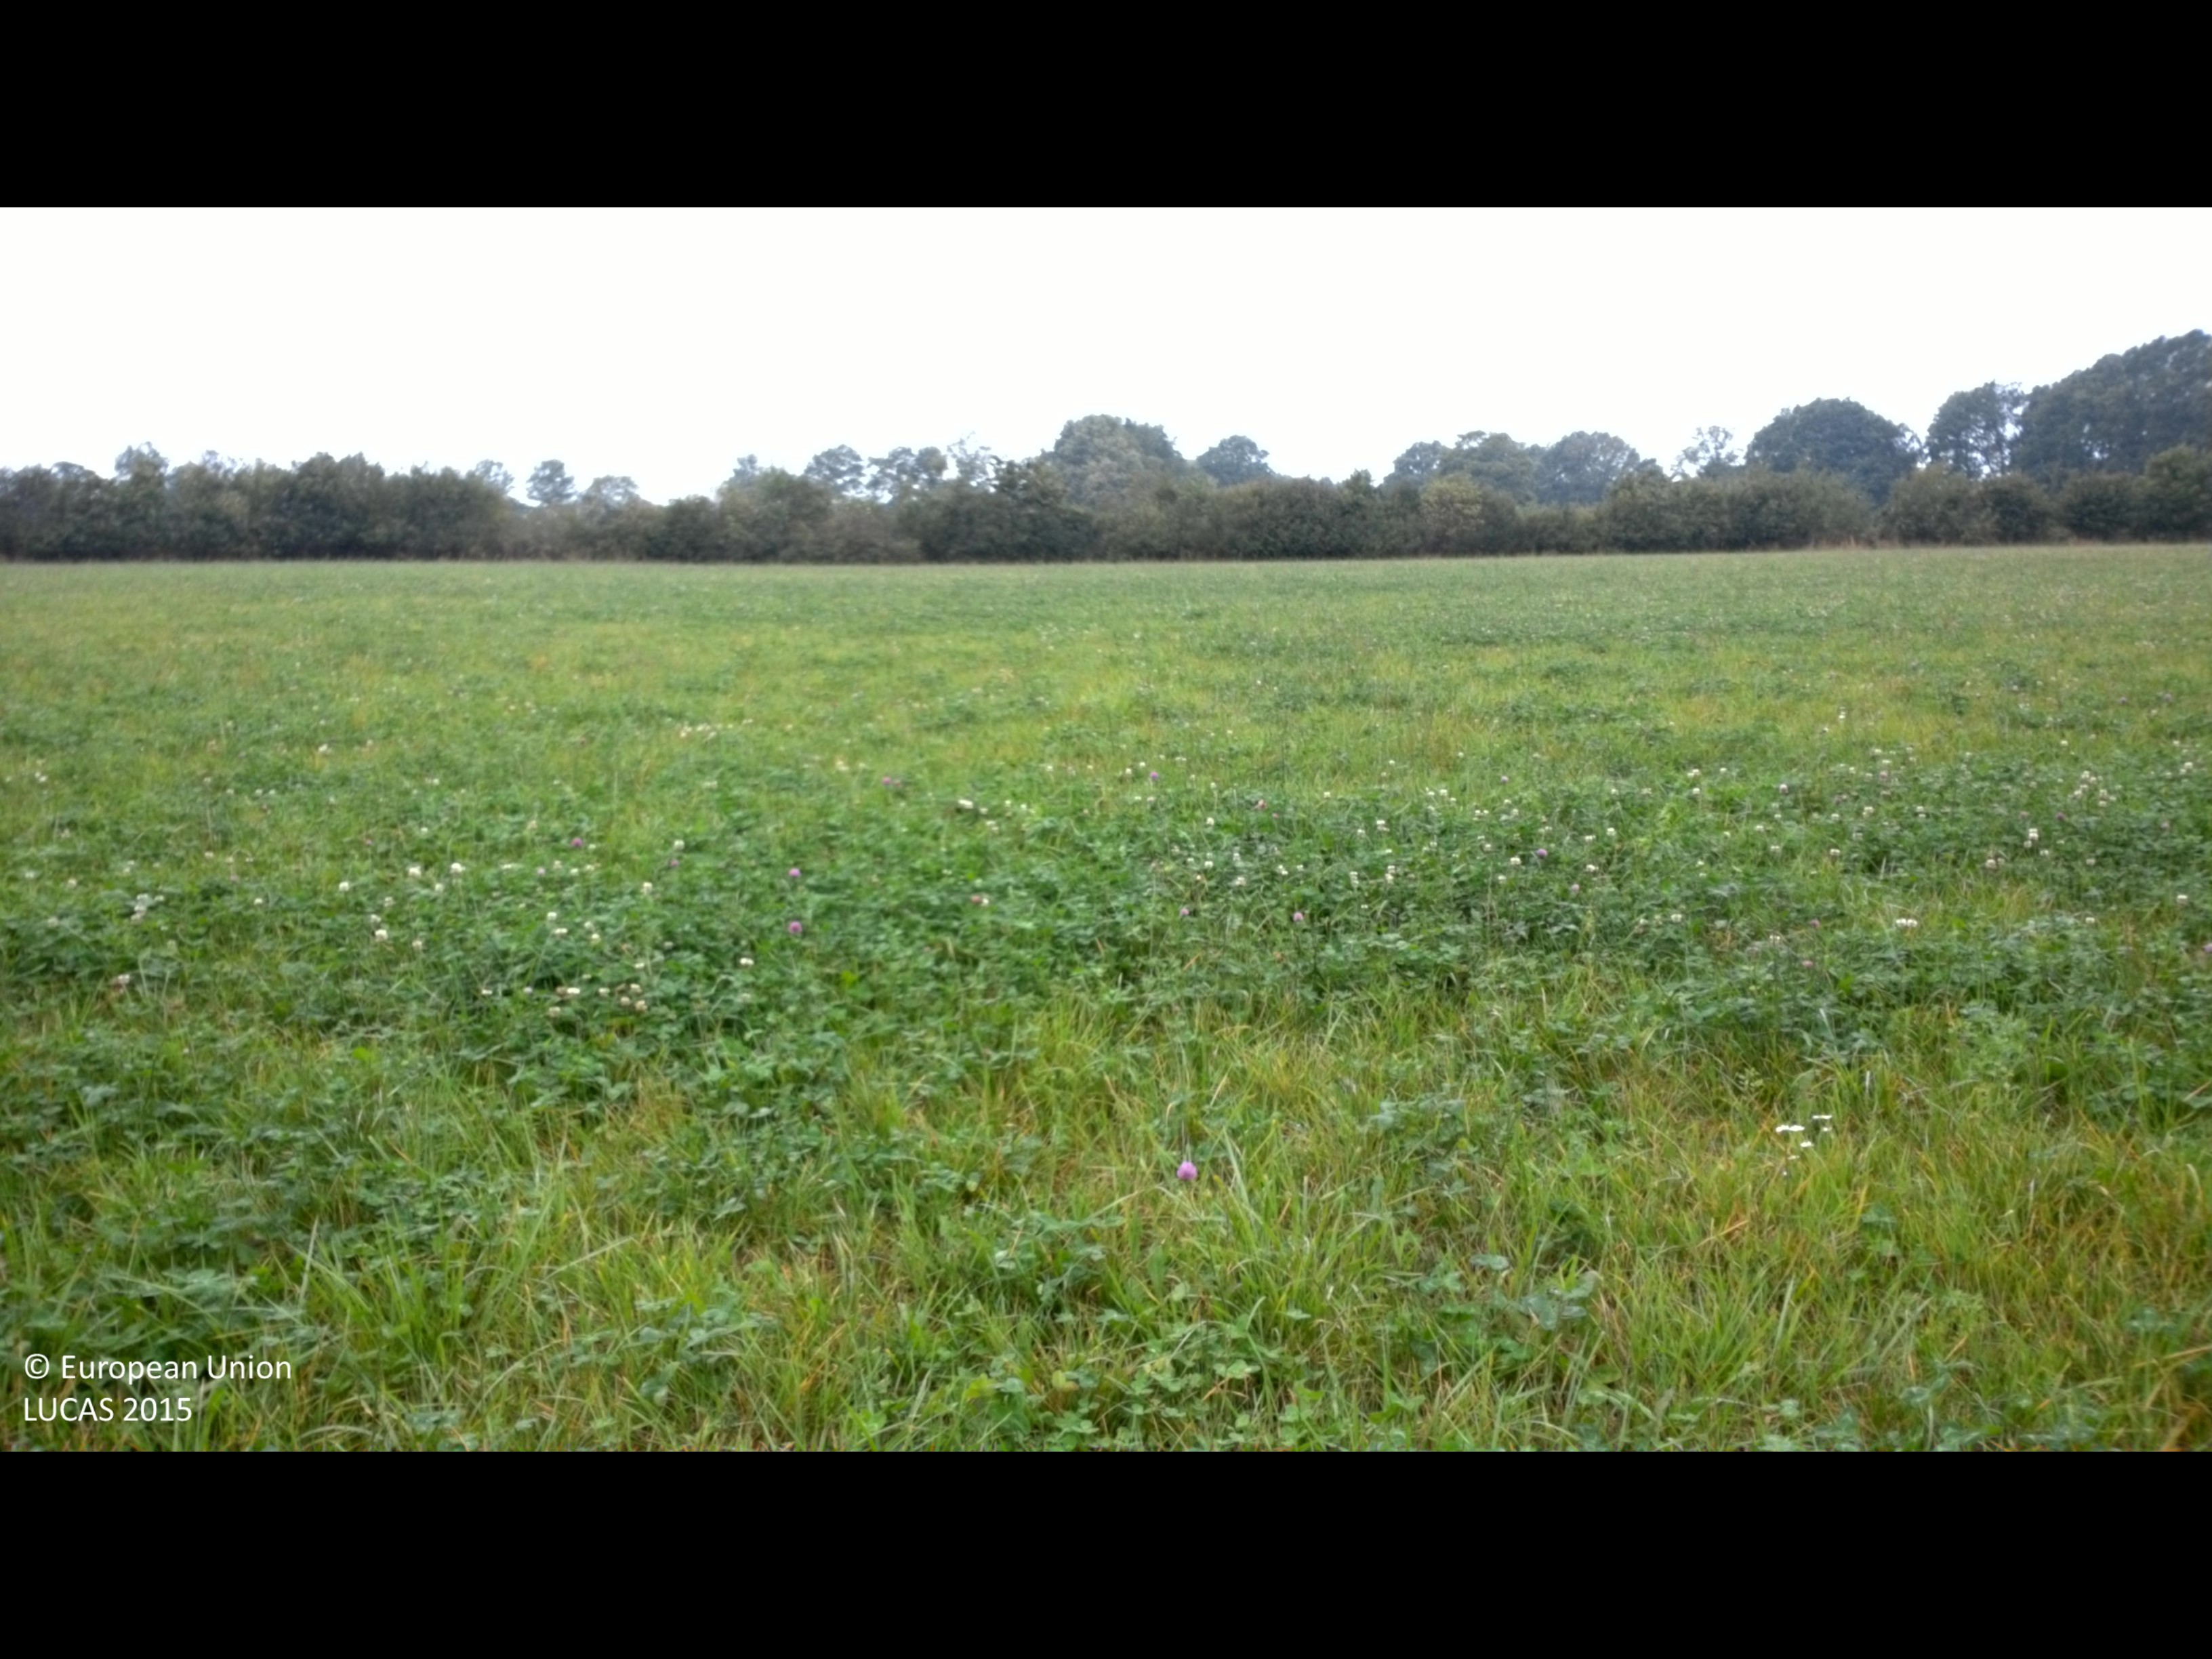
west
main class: Cropland
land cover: Clovers
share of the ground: > 75 %
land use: Agriculture (excluding fallow land and kitchen gardens)
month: September
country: SE
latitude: 55.9629
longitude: 14.0188
